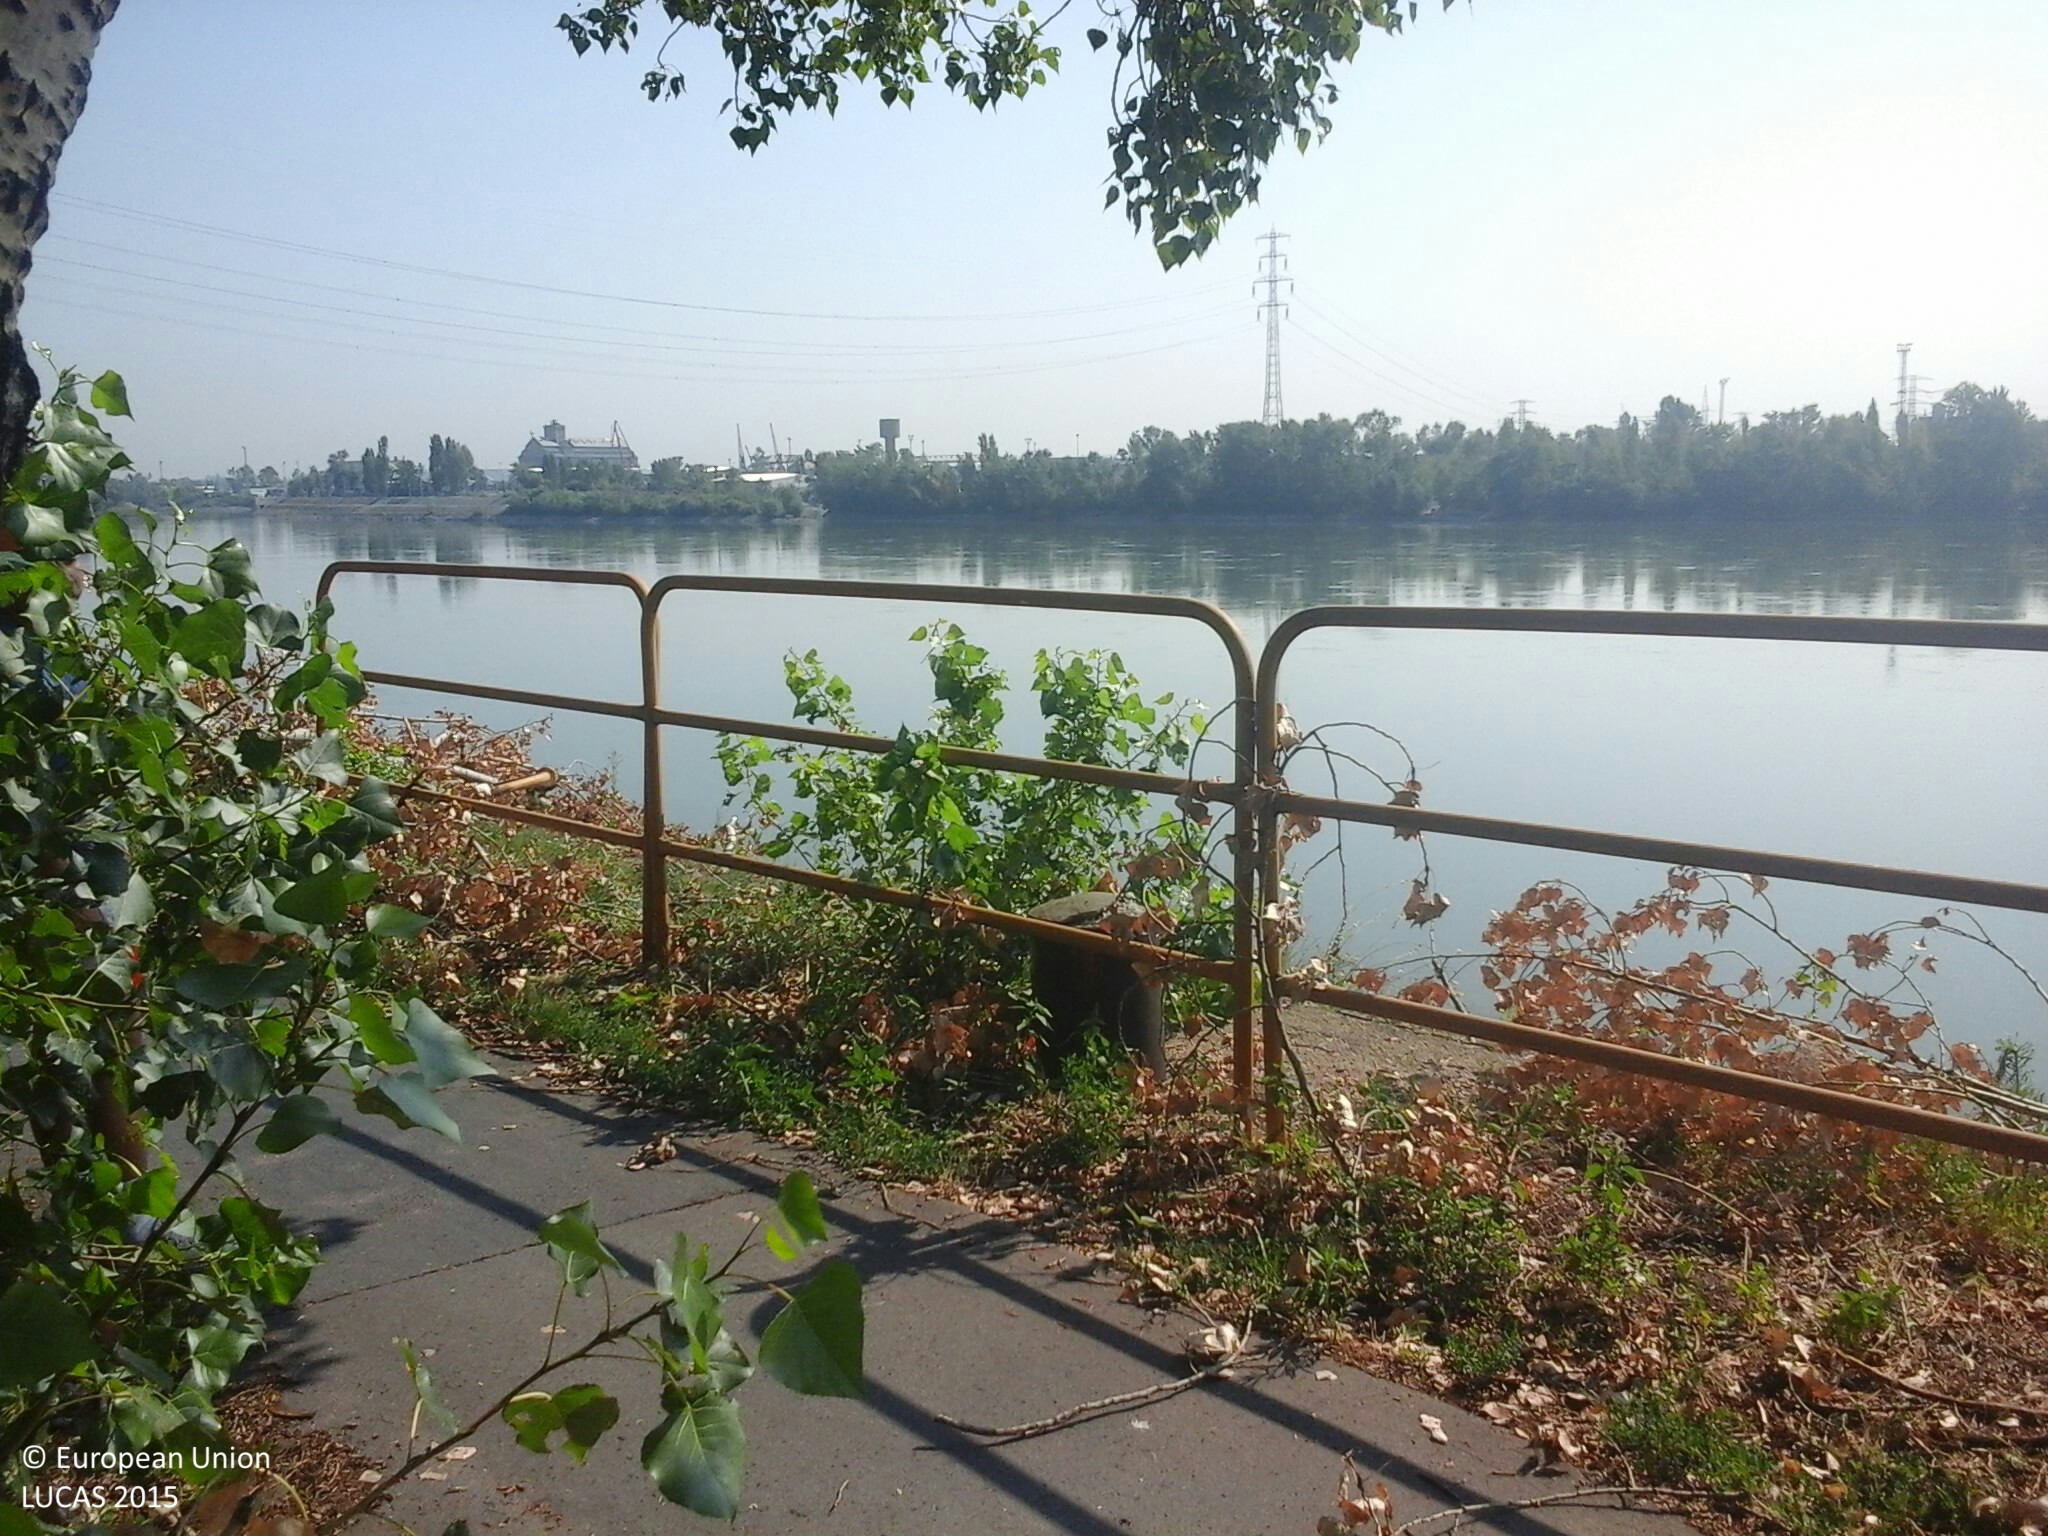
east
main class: Woodland
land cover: Broadleaved woodland
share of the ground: > 75 %
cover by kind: broadleaved forest trees 100 %
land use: Amenities, museums, leisure
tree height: > 5 m
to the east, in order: Broadleaved woodland; Artificial constructions in urban areas; Inland fresh running water
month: August
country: HU
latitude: 47.4345
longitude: 19.0468
